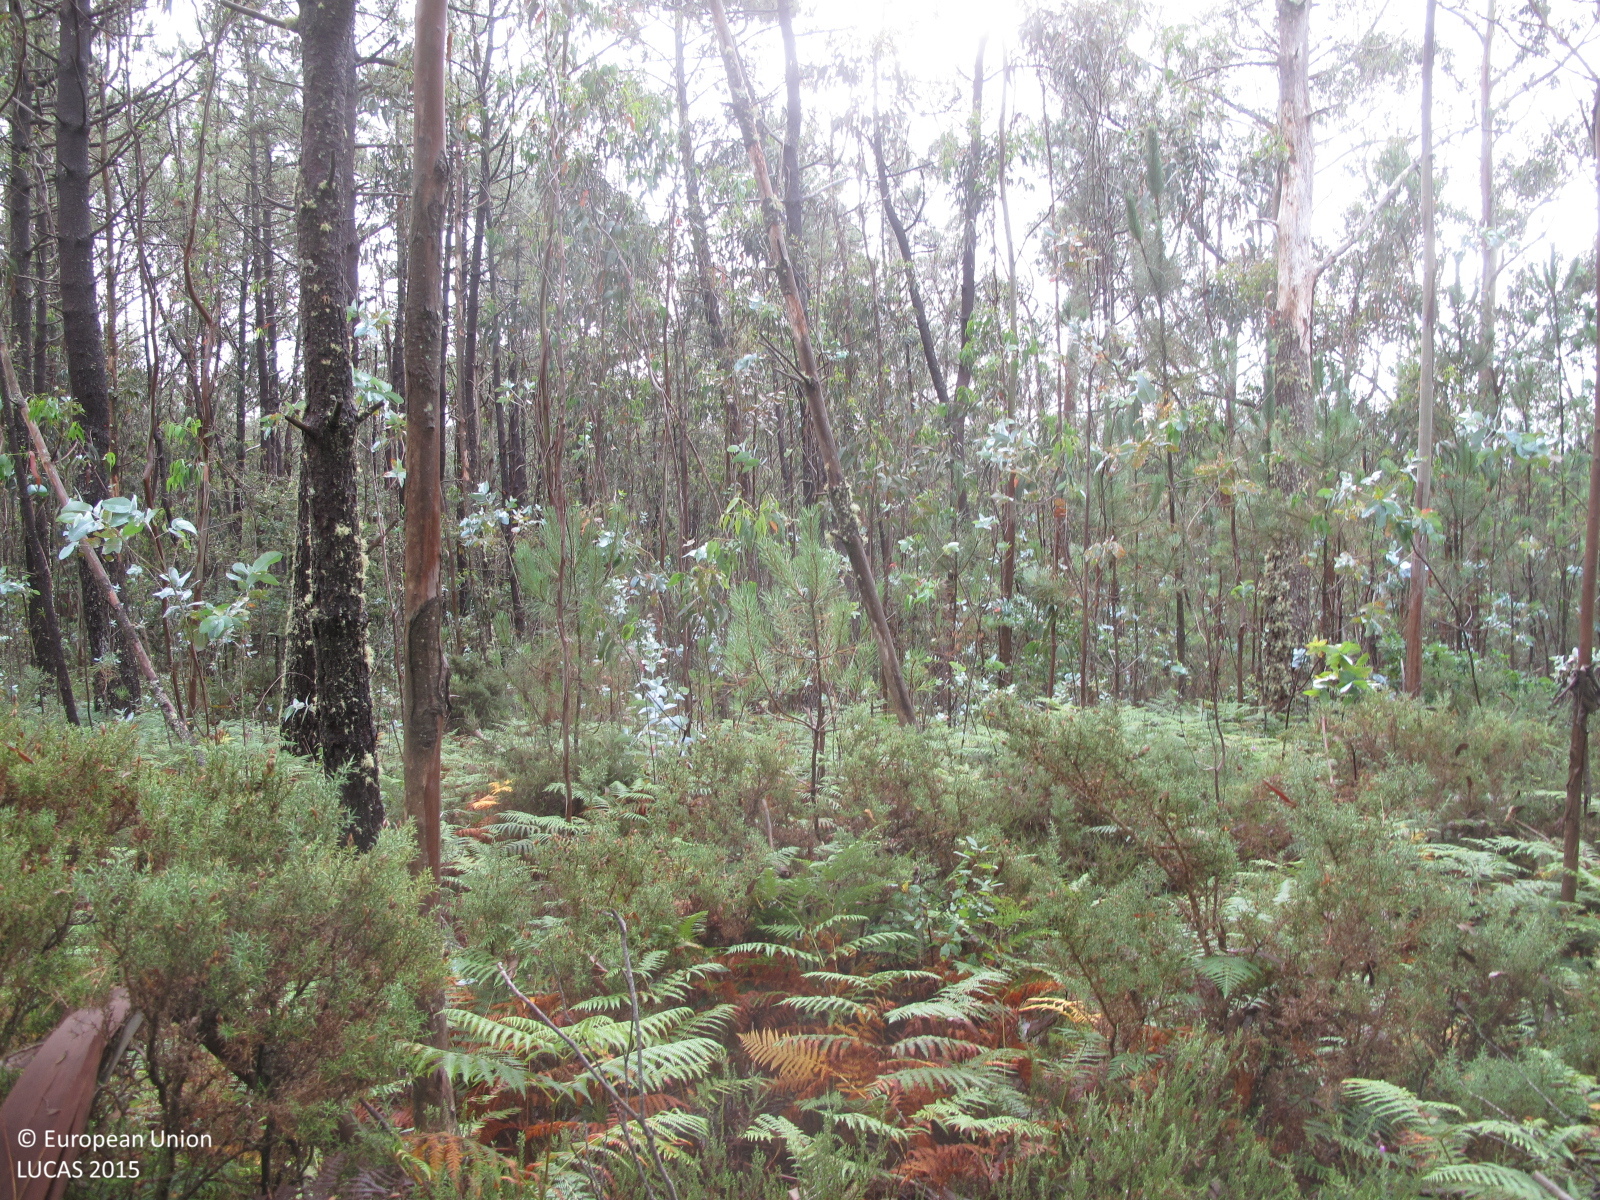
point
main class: Woodland
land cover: Pine dominated mixed woodland
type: hemiboreal forest and nemoral coniferous forest and mixed broadleaved-coniferous forest
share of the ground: 50 - 75 %
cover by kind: coniferous forest trees 40 %, broadleaved forest trees 30 %, shrubs 20 %, herbaceous plants 10 %
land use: Forestry
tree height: > 5 m
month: July
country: ES
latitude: 43.0646
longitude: -9.1481
